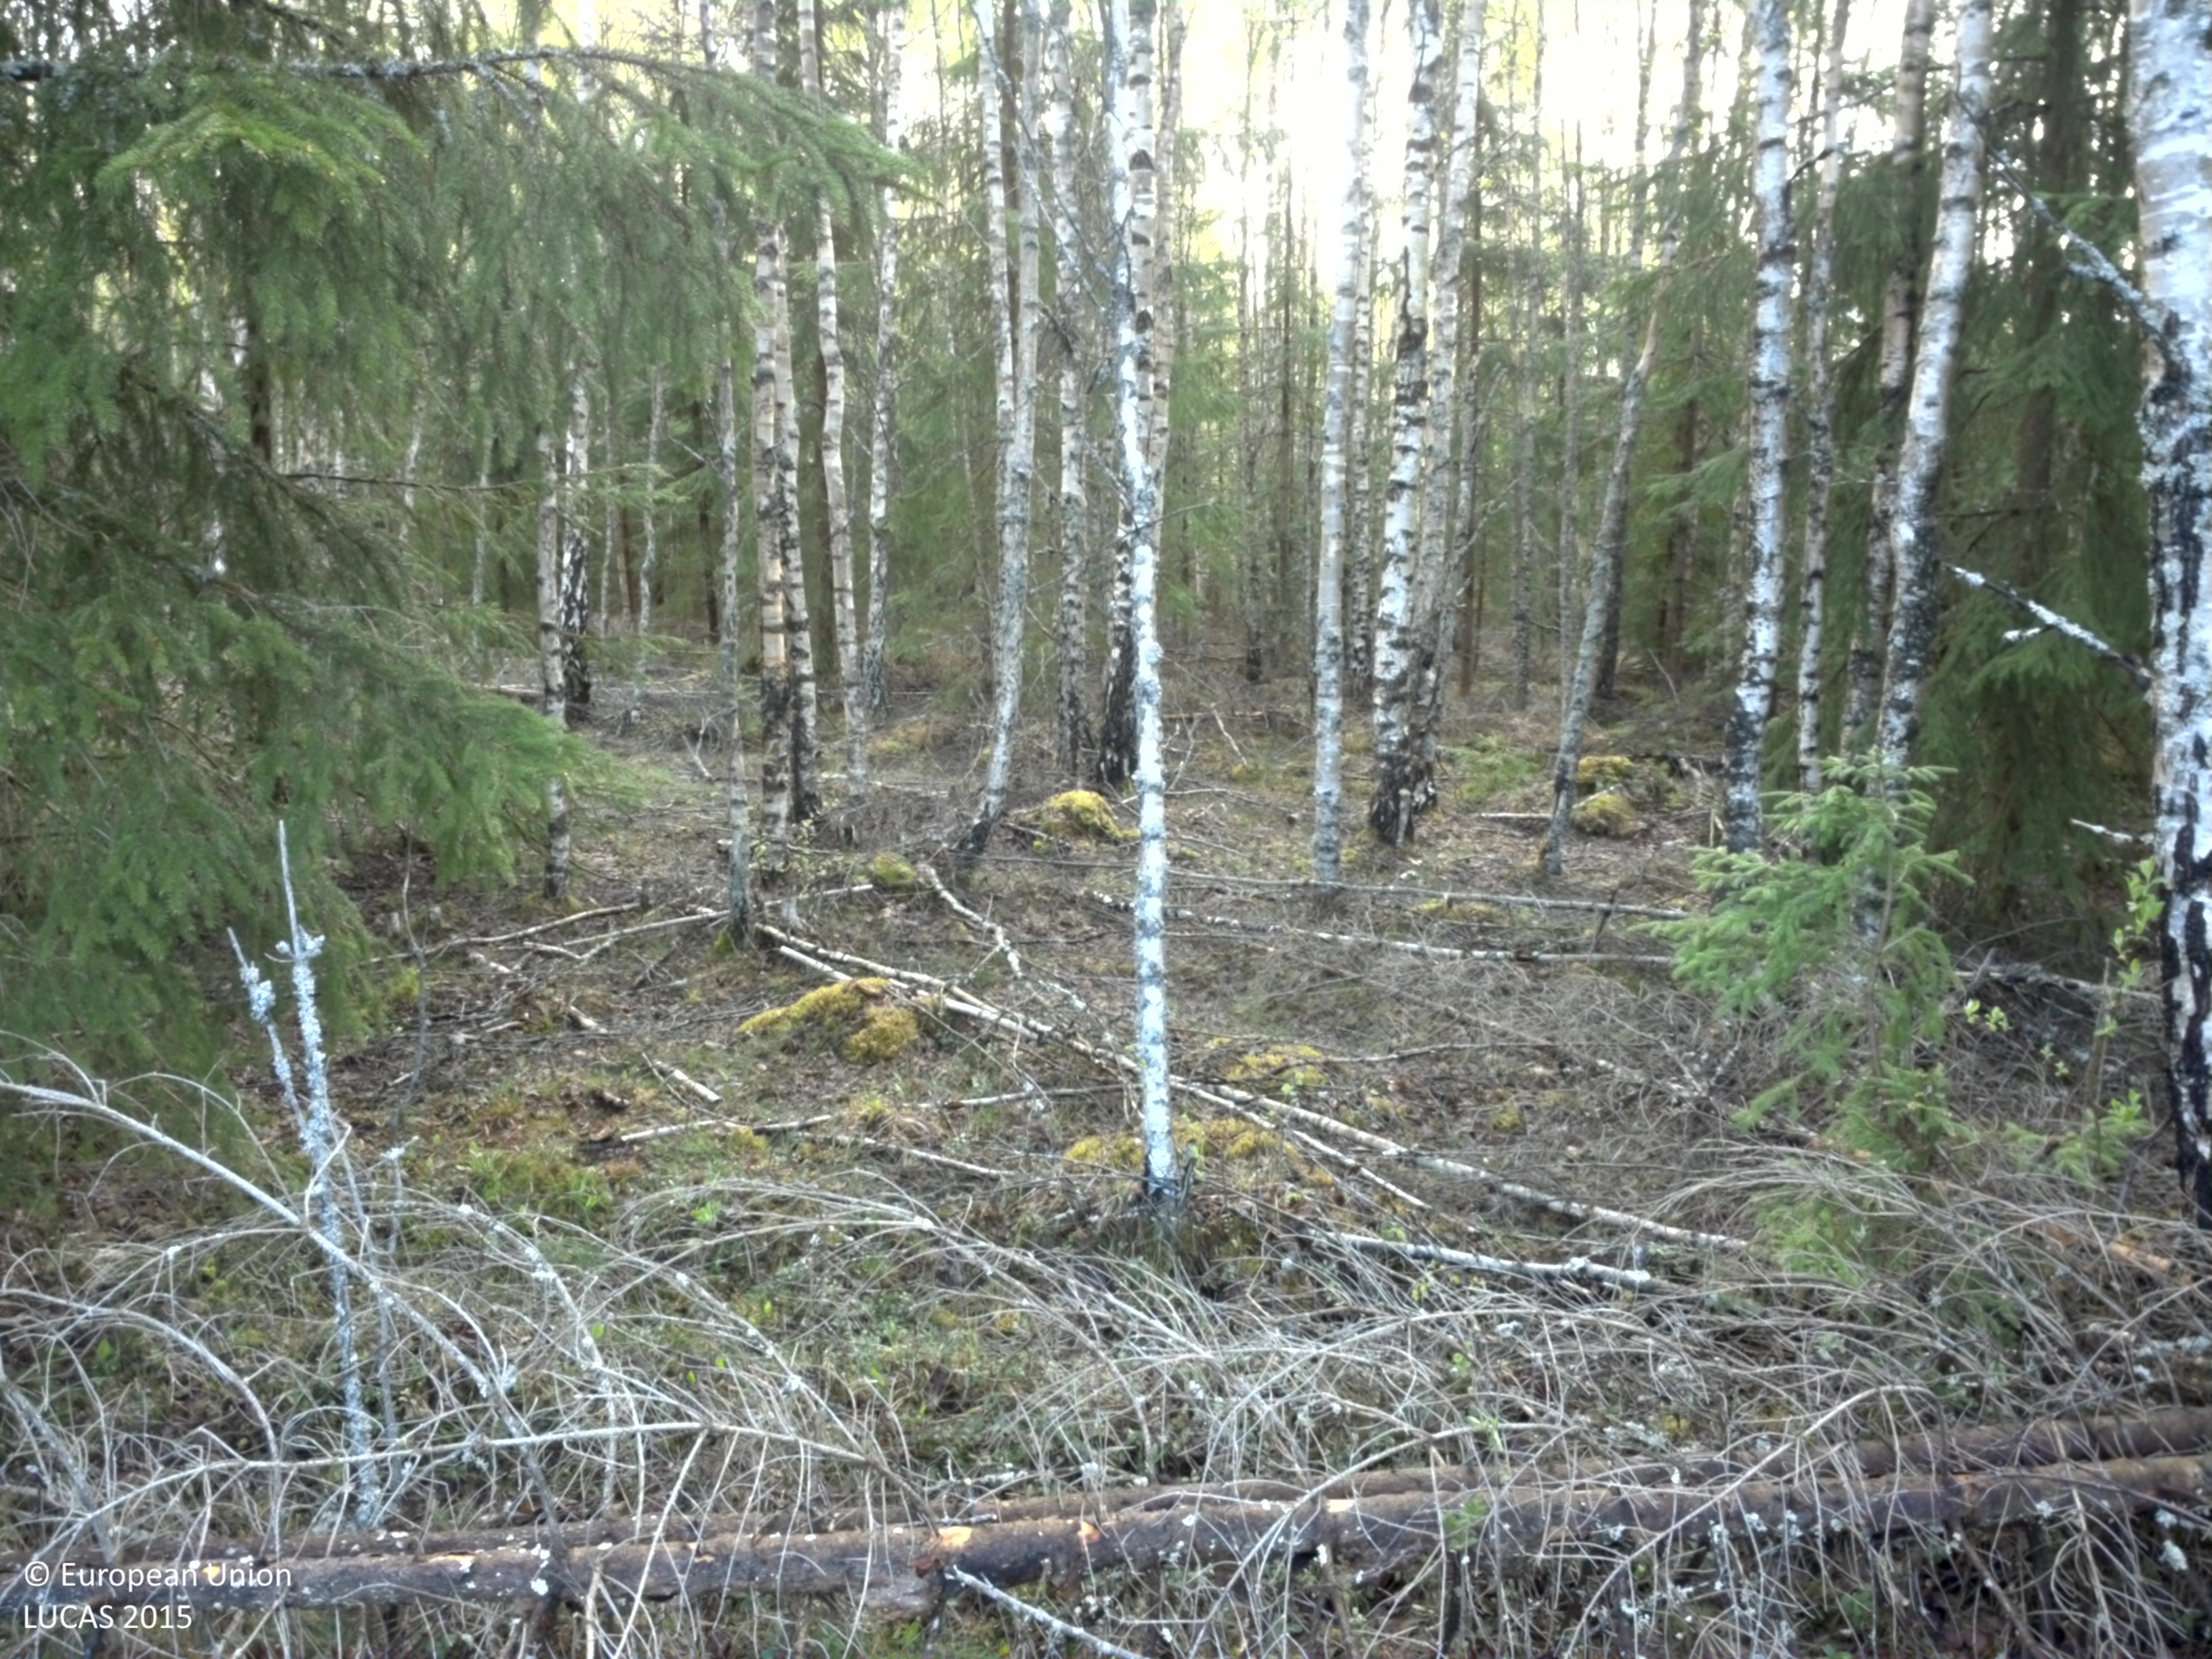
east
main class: Woodland
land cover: Broadleaved woodland
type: hemiboreal forest and nemoral coniferous forest and mixed broadleaved-coniferous forest
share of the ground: 10 - 25 %
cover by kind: herbaceous plants 50 %, shrubs 30 %, broadleaved forest trees 10 %, lichens and mosses 10 %
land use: Electricity, gas and thermal power distribution
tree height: < 5 m
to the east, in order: Other mixed woodland; Spruce dominated mixed woodland; Rivers and streams; Spruce dominated mixed woodland; Other mixed woodland; Tracks; Other mixed woodland; Broadleaved woodland
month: May
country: SE
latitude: 59.2905
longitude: 14.1524
